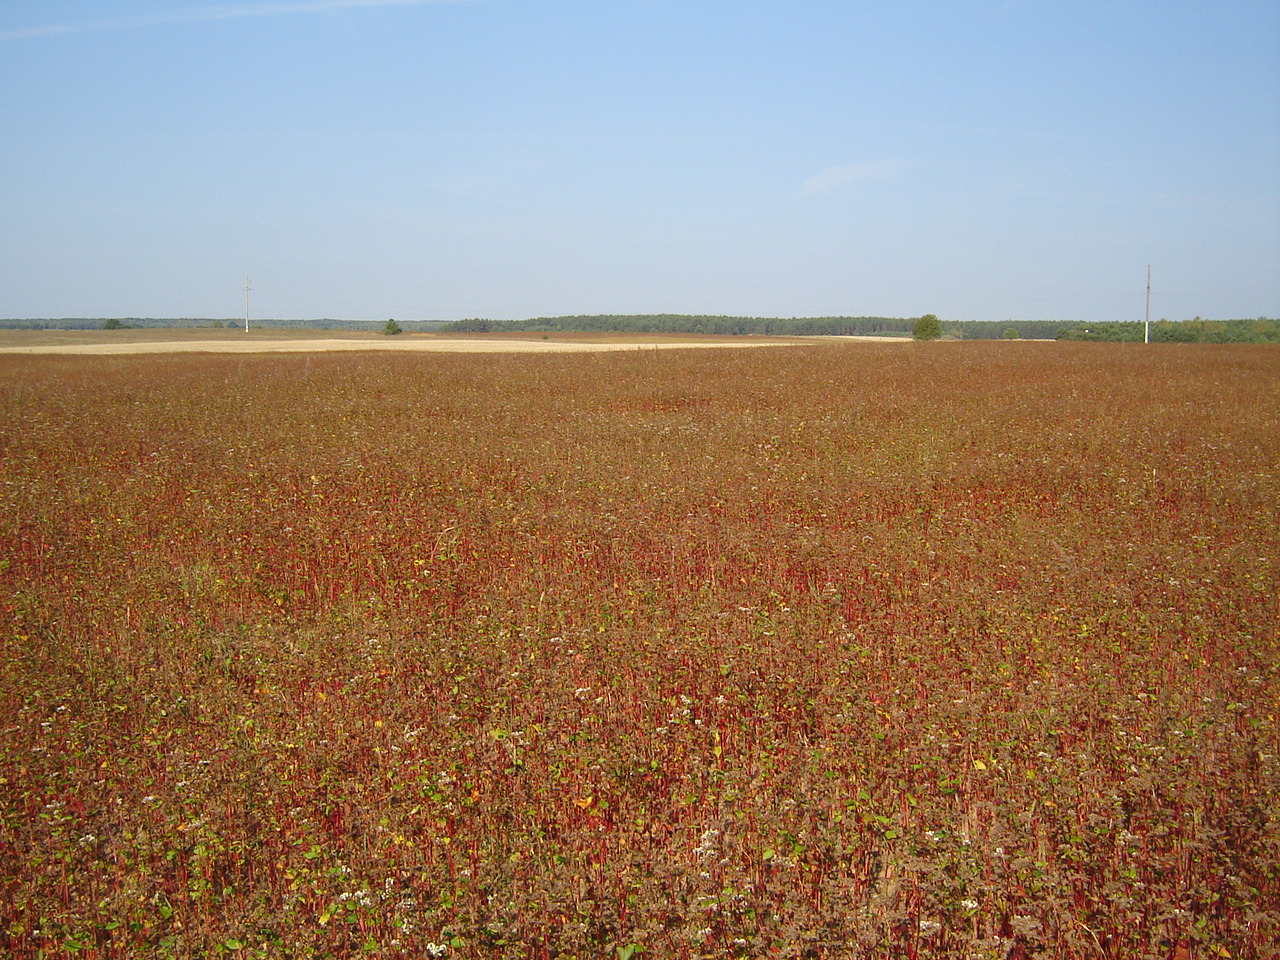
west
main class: Cropland
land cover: Other cereals
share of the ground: > 75 %
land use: Agriculture (excluding fallow land and kitchen gardens)
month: August
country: LT
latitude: 54.5796
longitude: 24.8872
